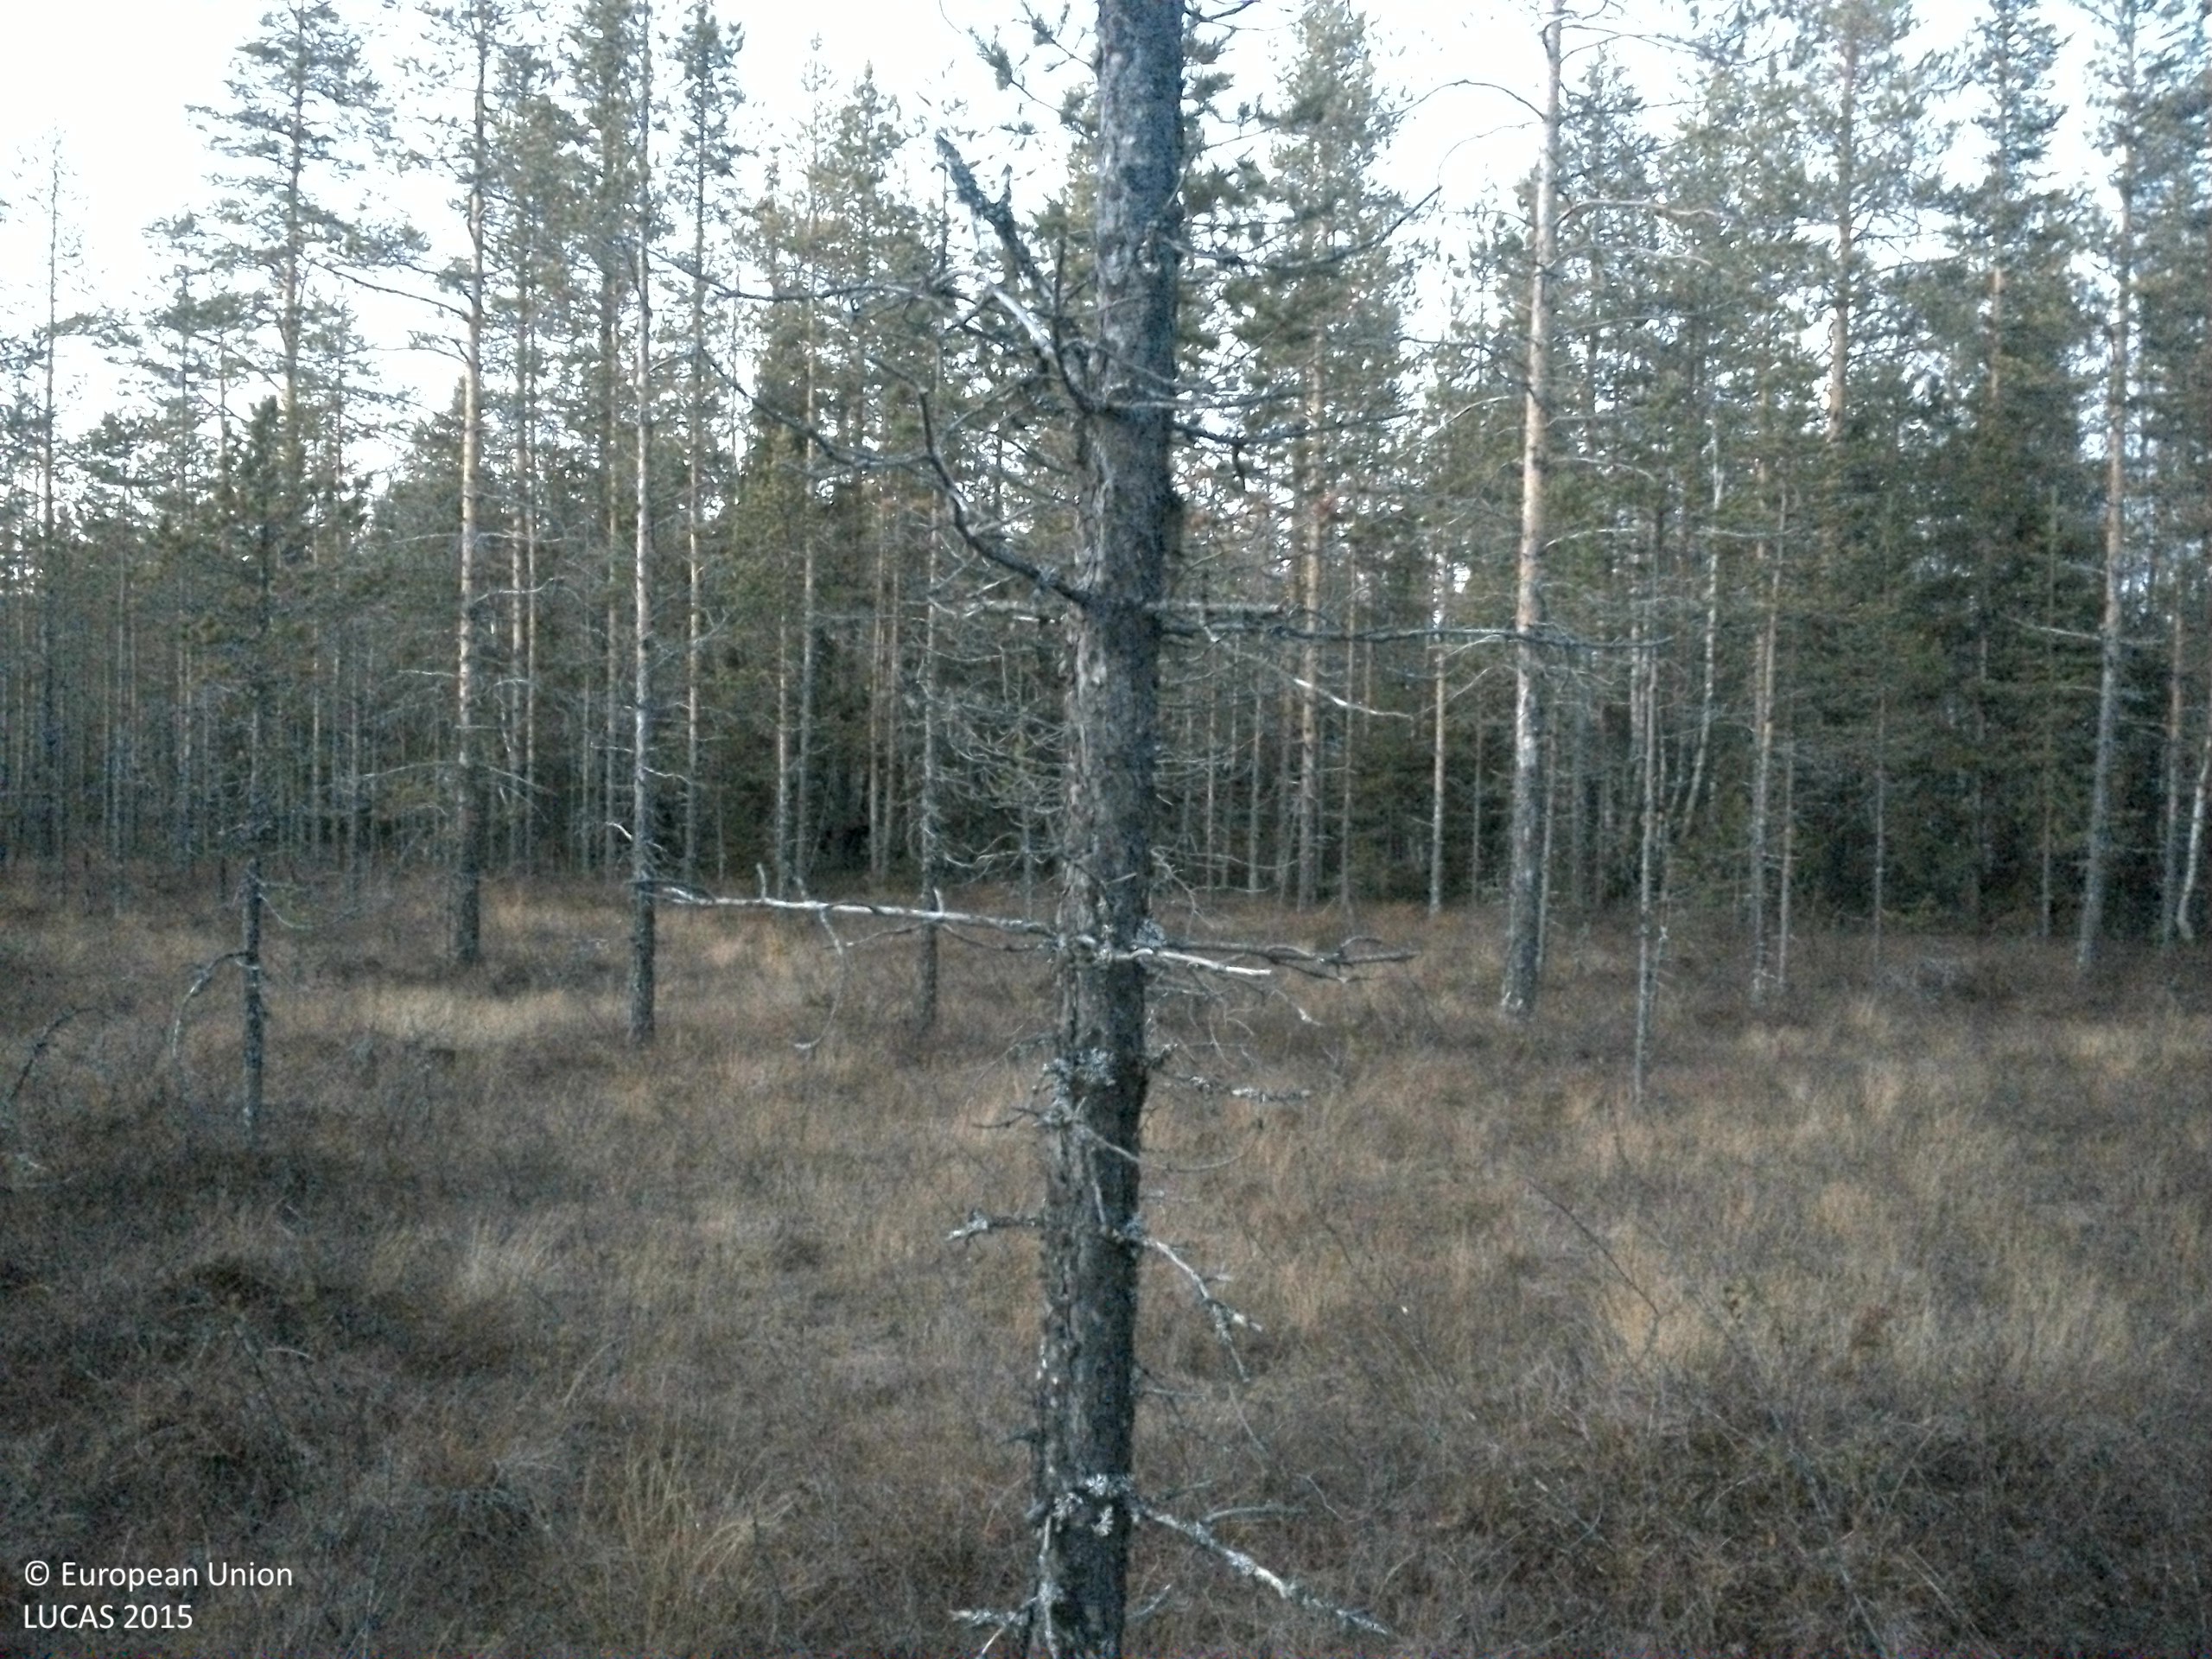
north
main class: Woodland
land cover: Pine dominated coniferous woodland
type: mire and swamp forests
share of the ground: 10 - 25 %
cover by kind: lichens and mosses 30 %, shrubs 25 %, herbaceous plants 25 %, coniferous forest trees 20 %
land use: Semi-natural and natural areas not in use
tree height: > 5 m
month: October
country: SE
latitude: 63.9845
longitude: 15.7959
